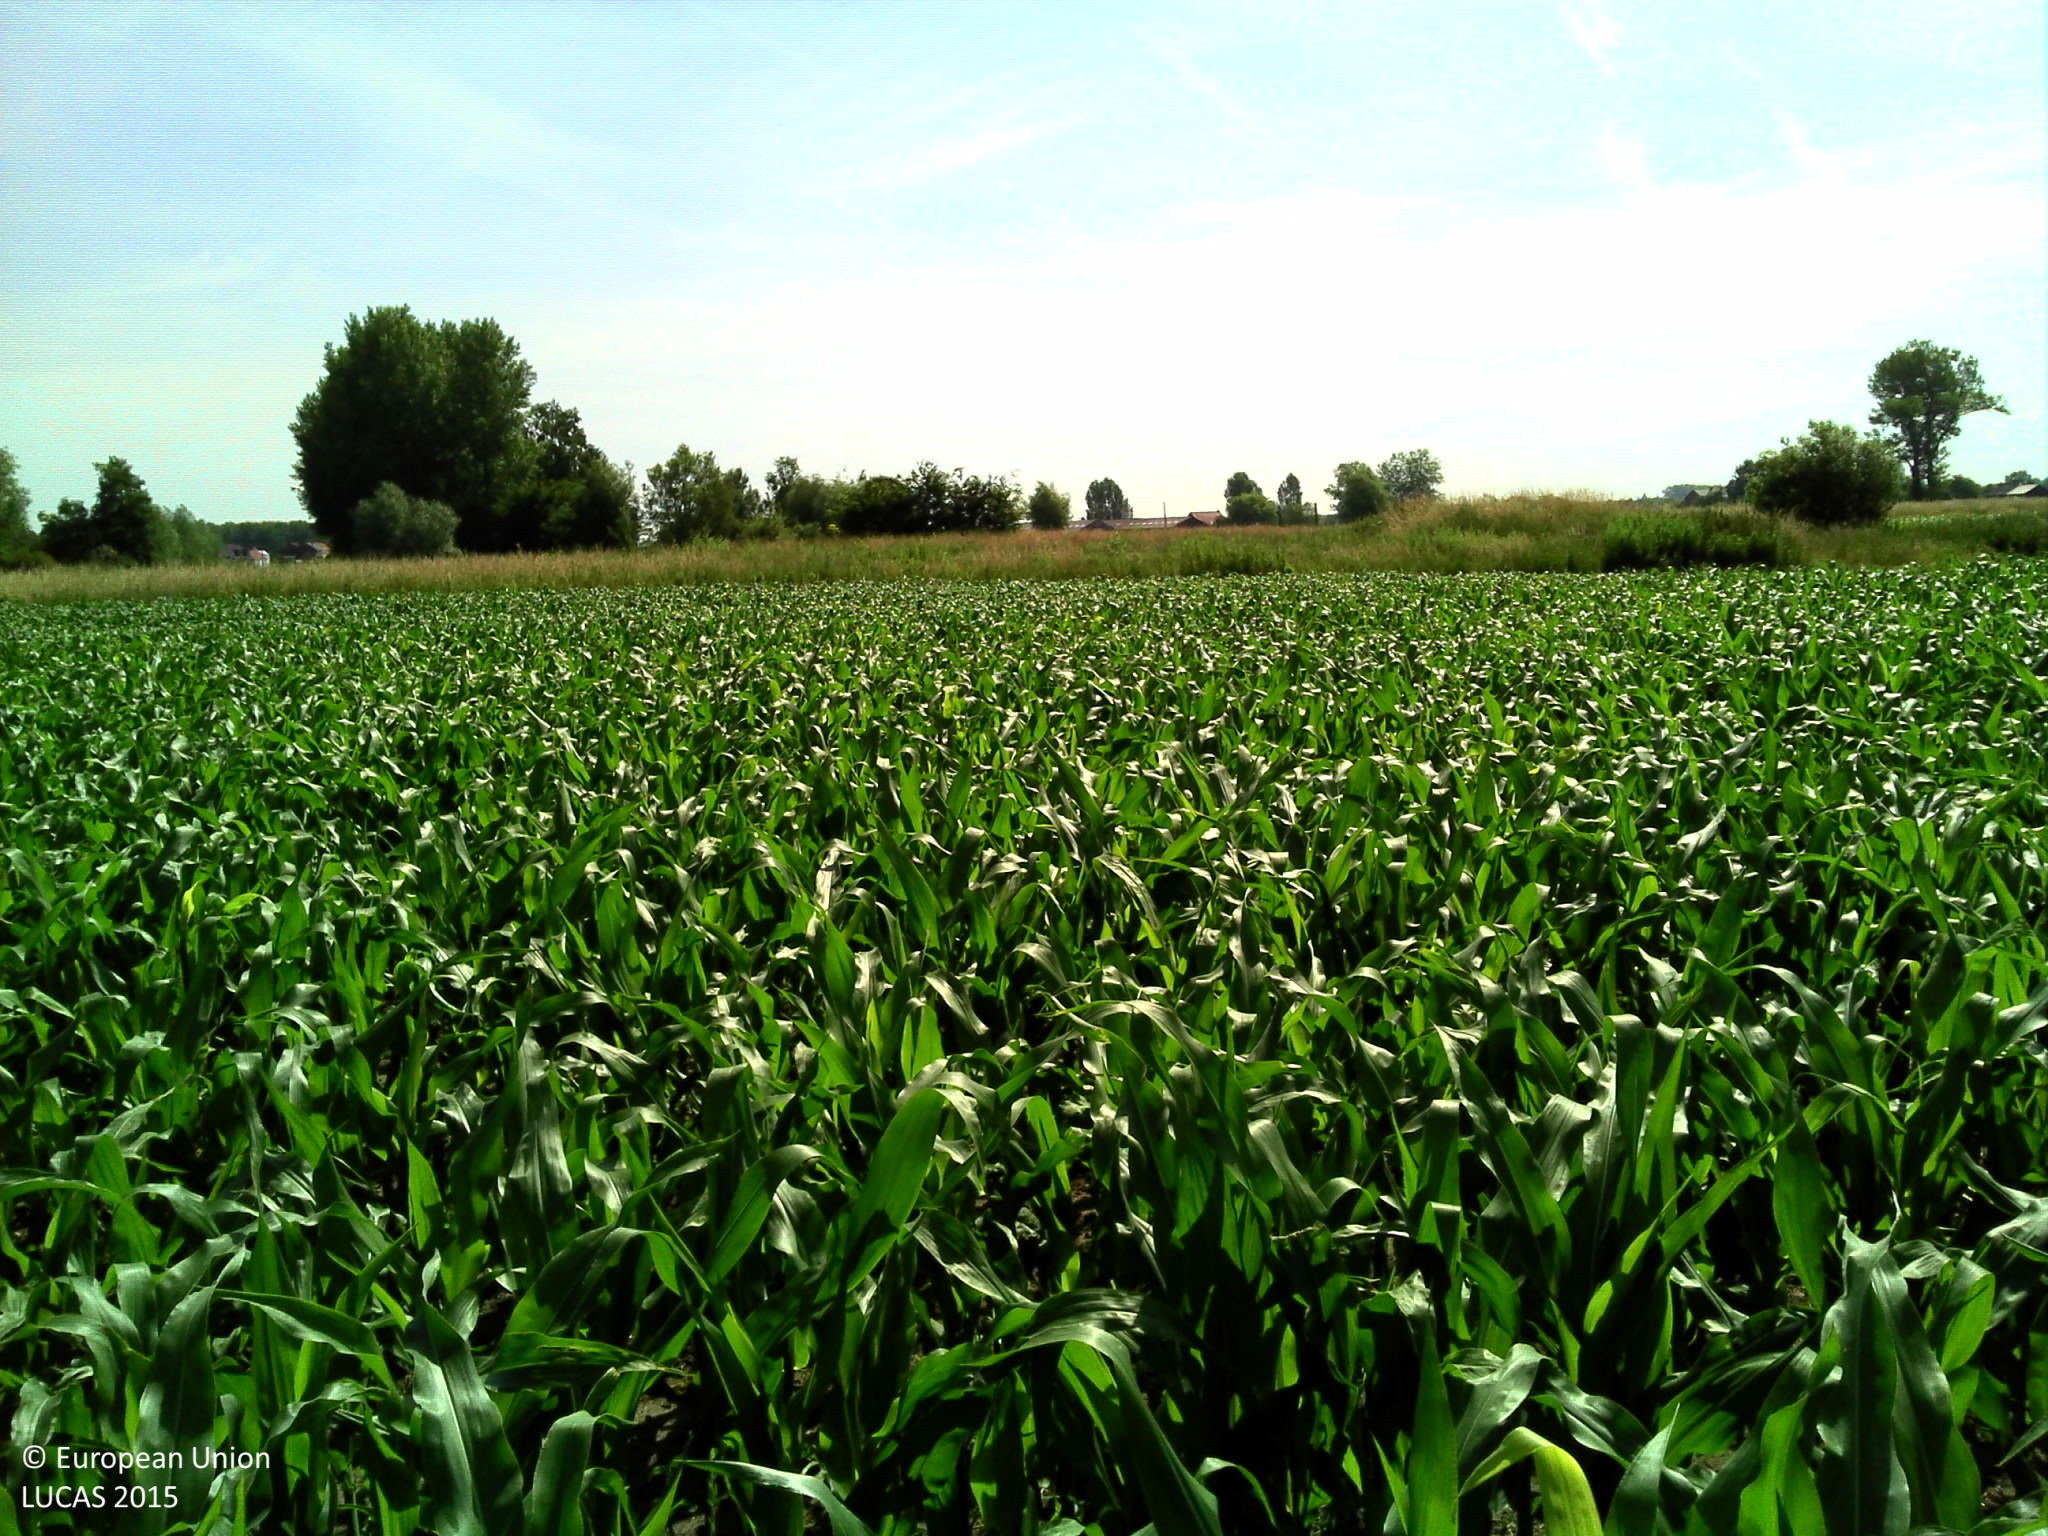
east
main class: Cropland
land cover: Maize
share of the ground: 50 - 75 %
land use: Agriculture (excluding fallow land and kitchen gardens)
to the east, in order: Maize; Grass margins; Spontaneously vegetated surfaces; Maize; Grass margins; Fences; Grassland without tree/shrub cover
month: June
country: BE
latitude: 50.5066
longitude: 3.5487
